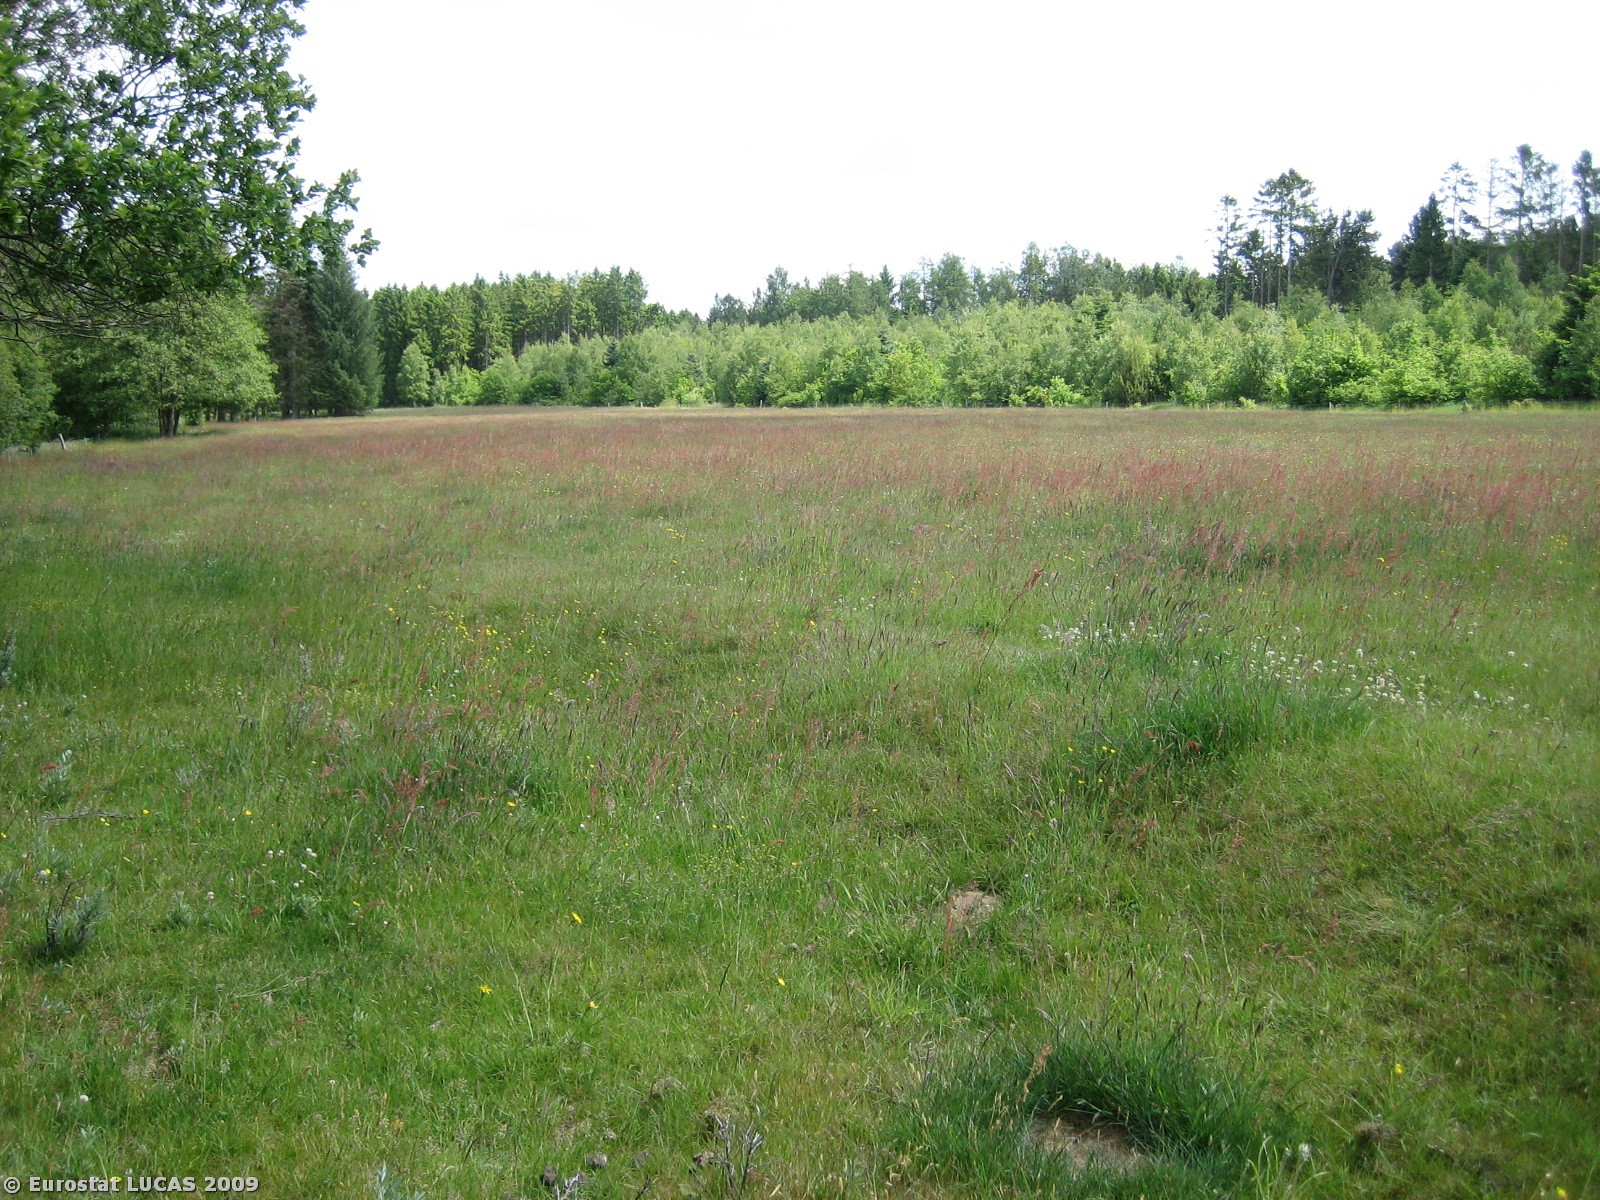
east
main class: Woodland
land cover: Broadleaved woodland
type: mesophytic deciduous forest
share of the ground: > 75 %
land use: Forestry
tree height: > 5 m
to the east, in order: Broadleaved woodland; Fences; Grassland without tree/shrub cover; Fences; Tracks; Broadleaved woodland; Grassland with sparse tree/shrub cover
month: June
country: DK
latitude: 56.0616
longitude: 9.7273
